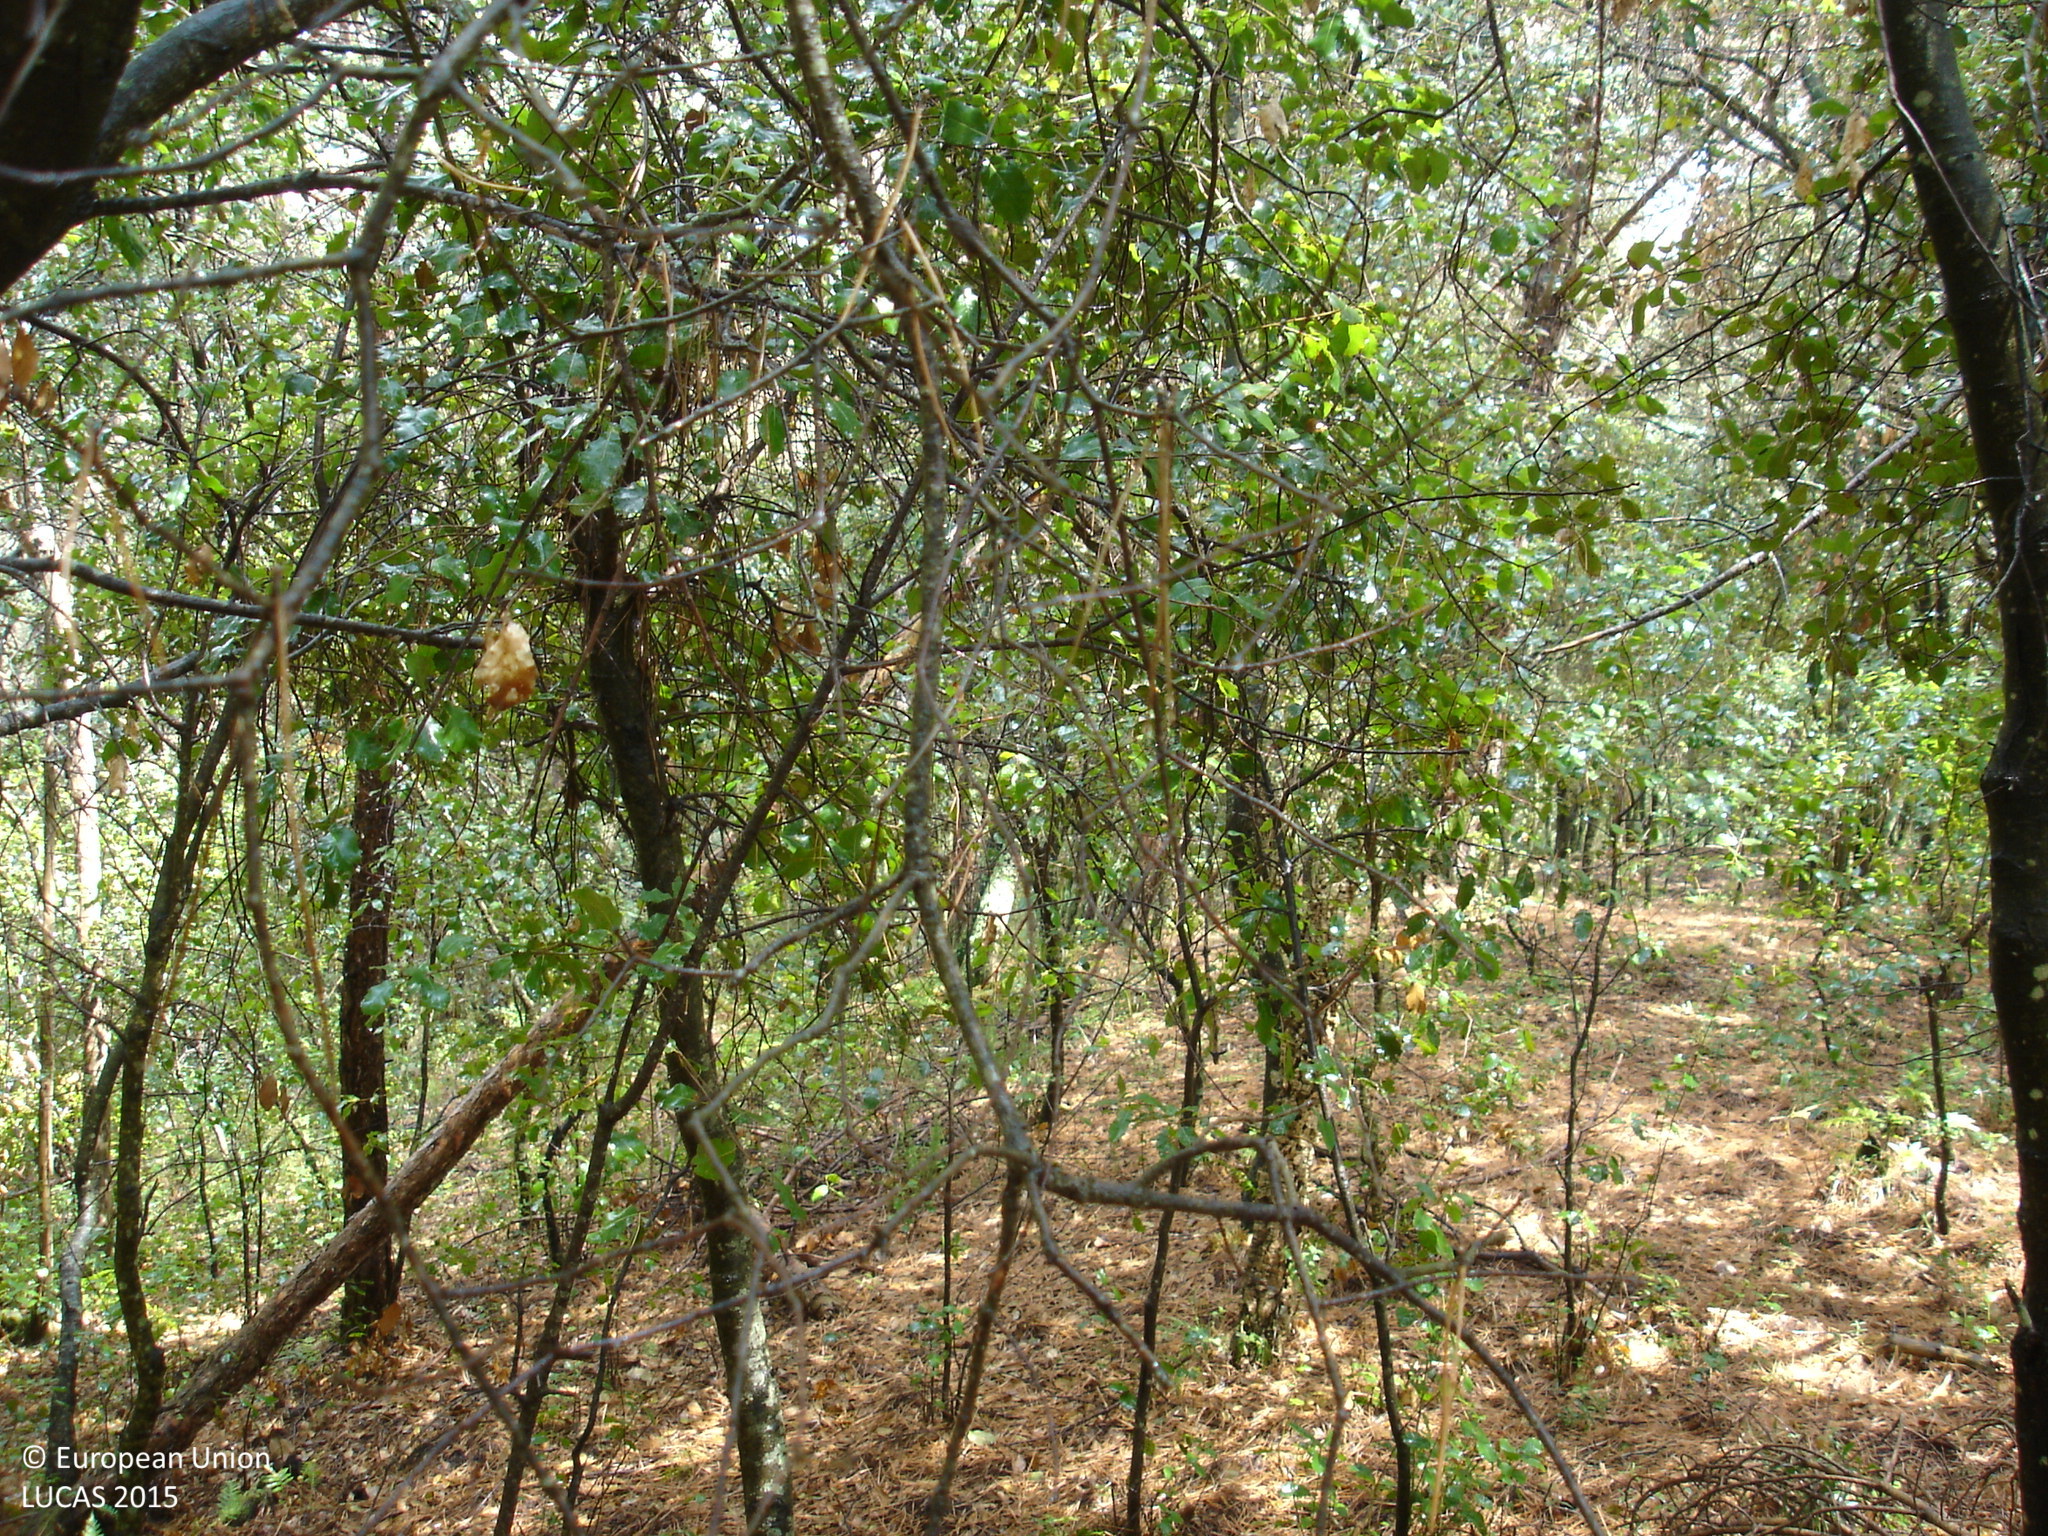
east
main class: Woodland
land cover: Other mixed woodland
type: thermophilous deciduous forest
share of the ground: > 75 %
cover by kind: broadleaved forest trees 75 %, coniferous forest trees 25 %
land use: Forestry
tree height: > 5 m
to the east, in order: Other mixed woodland; Pine dominated mixed woodland; Other mixed woodland; Tracks; Other mixed woodland; Pine dominated mixed woodland; Tracks; Other mixed woodland
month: June
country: ES
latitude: 41.8183
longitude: 2.5642
